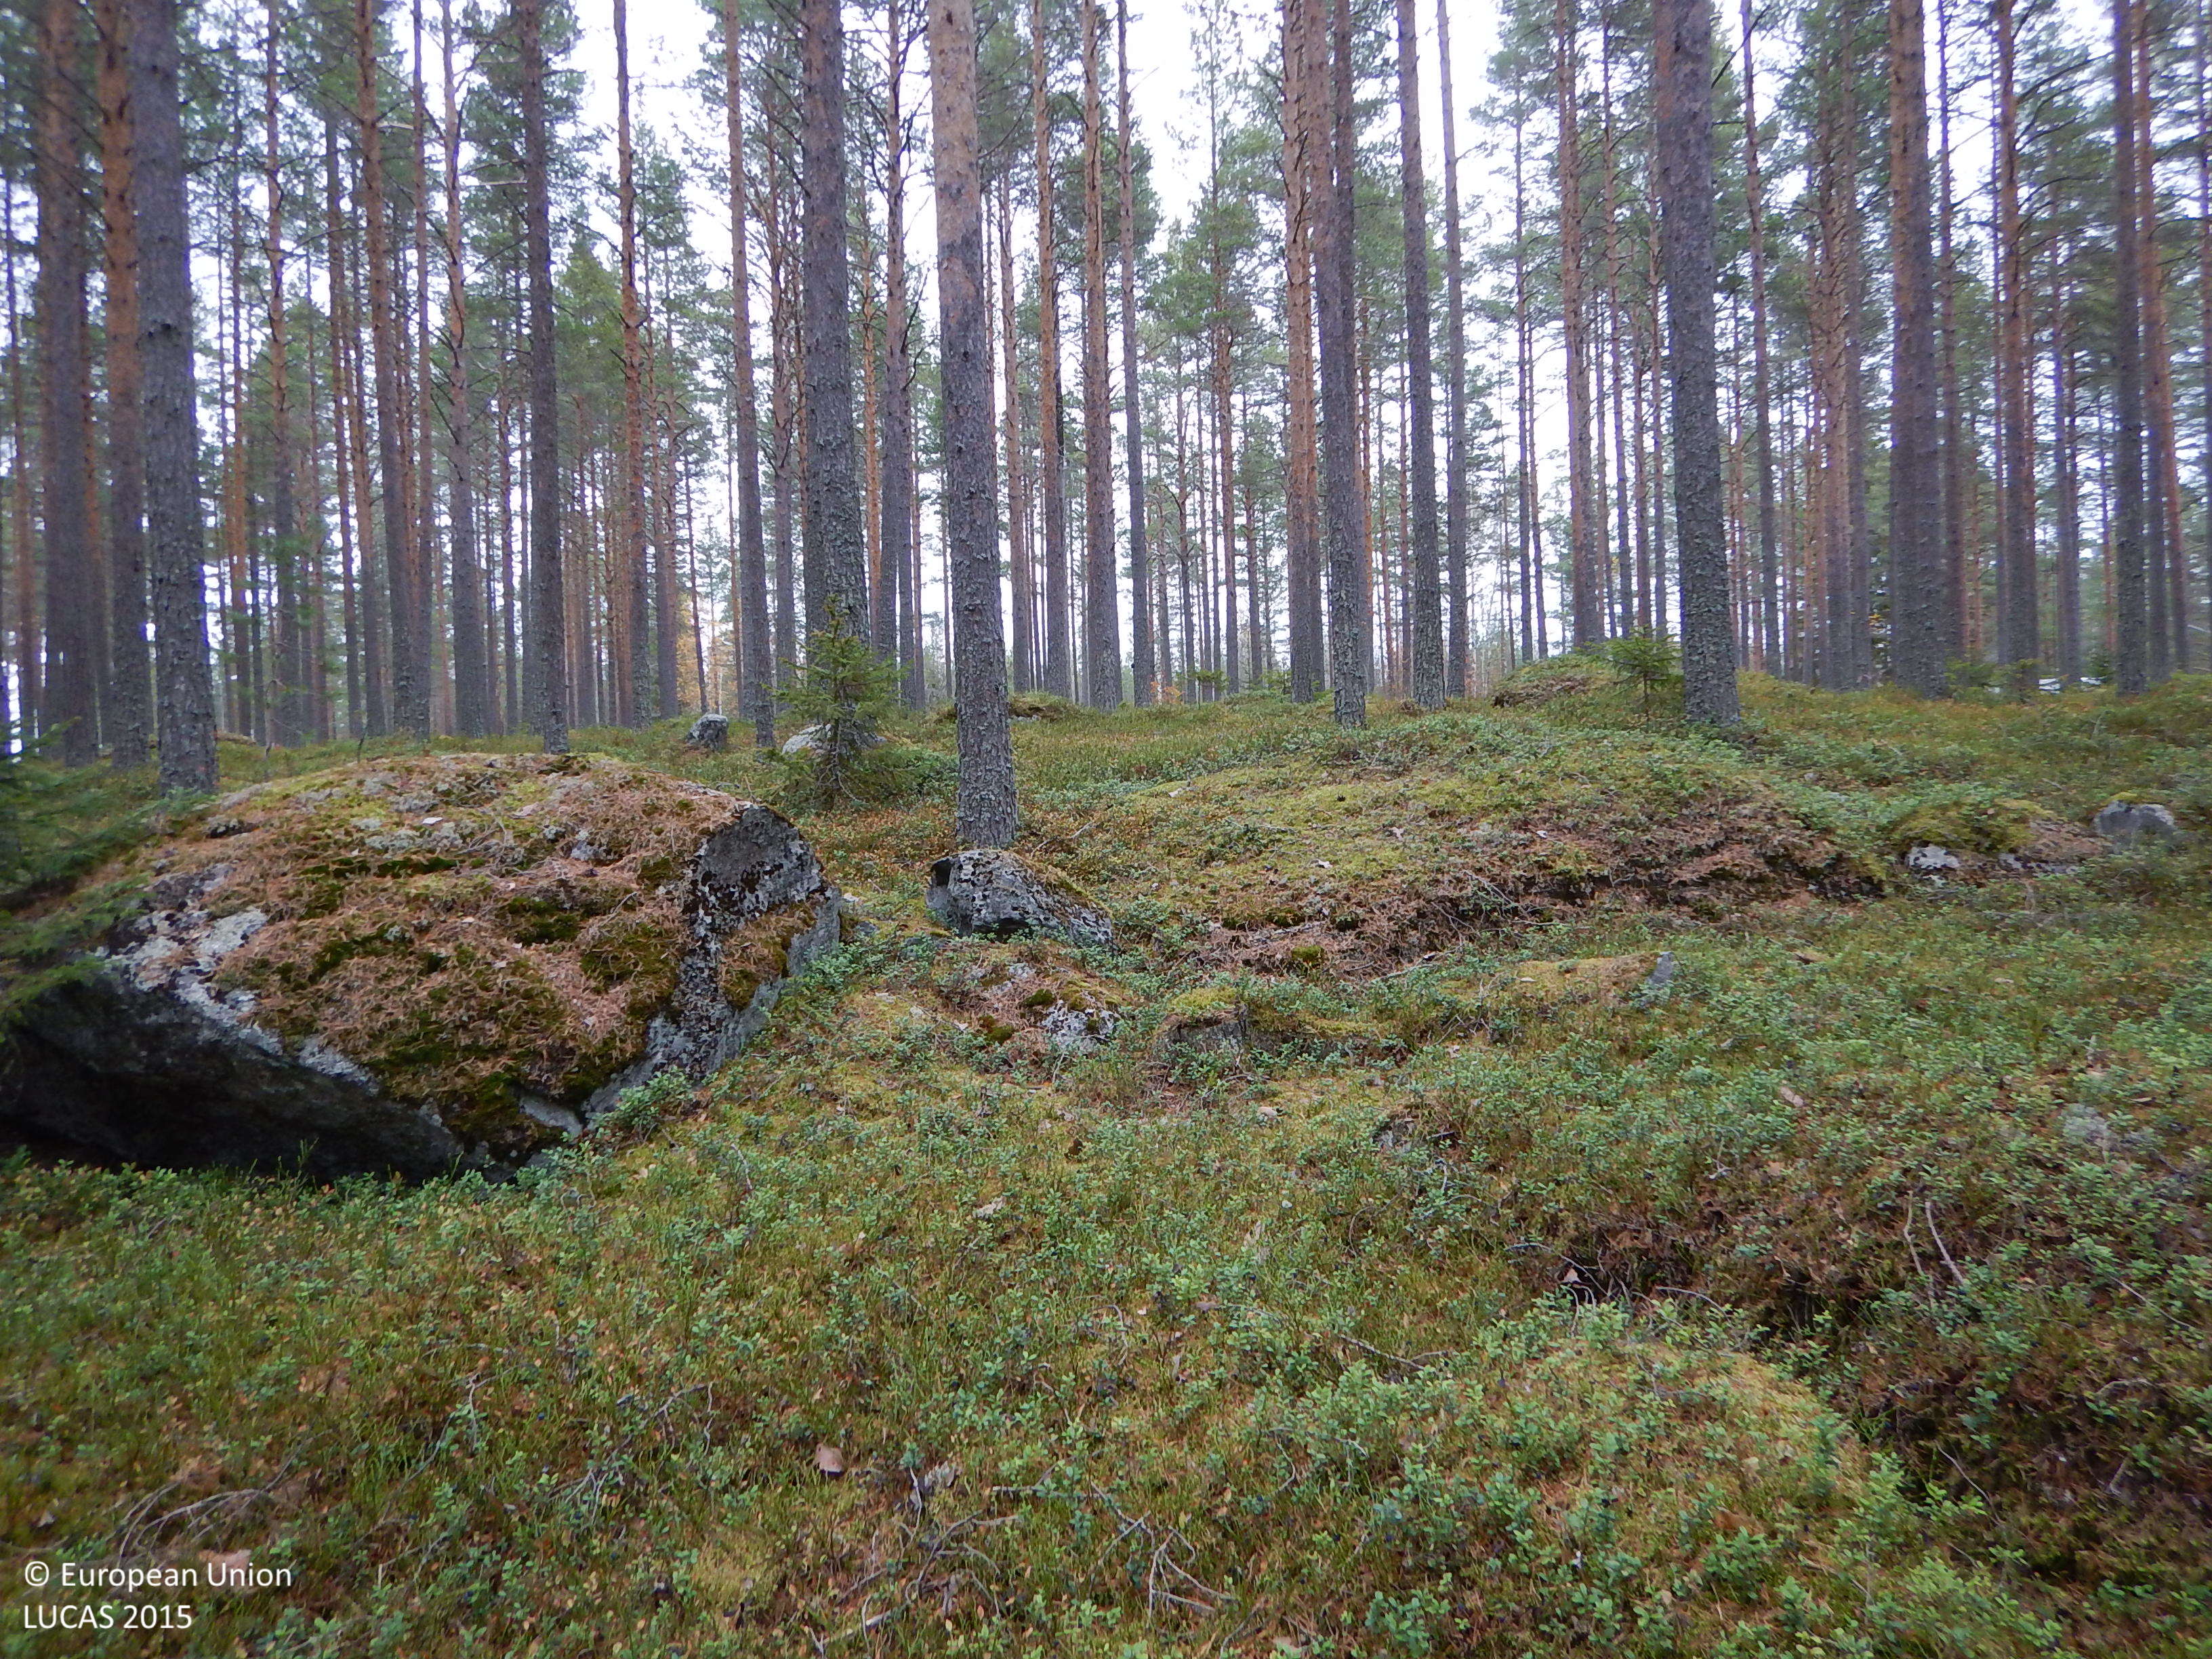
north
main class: Woodland
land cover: Pine dominated coniferous woodland
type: boreal forest
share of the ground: 50 - 75 %
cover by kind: coniferous forest trees 55 %, shrubs 15 %, herbaceous plants 15 %, lichens and mosses 15 %
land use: Forestry
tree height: > 5 m
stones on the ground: < 10 %
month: October
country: SE
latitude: 65.1159
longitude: 21.2006
